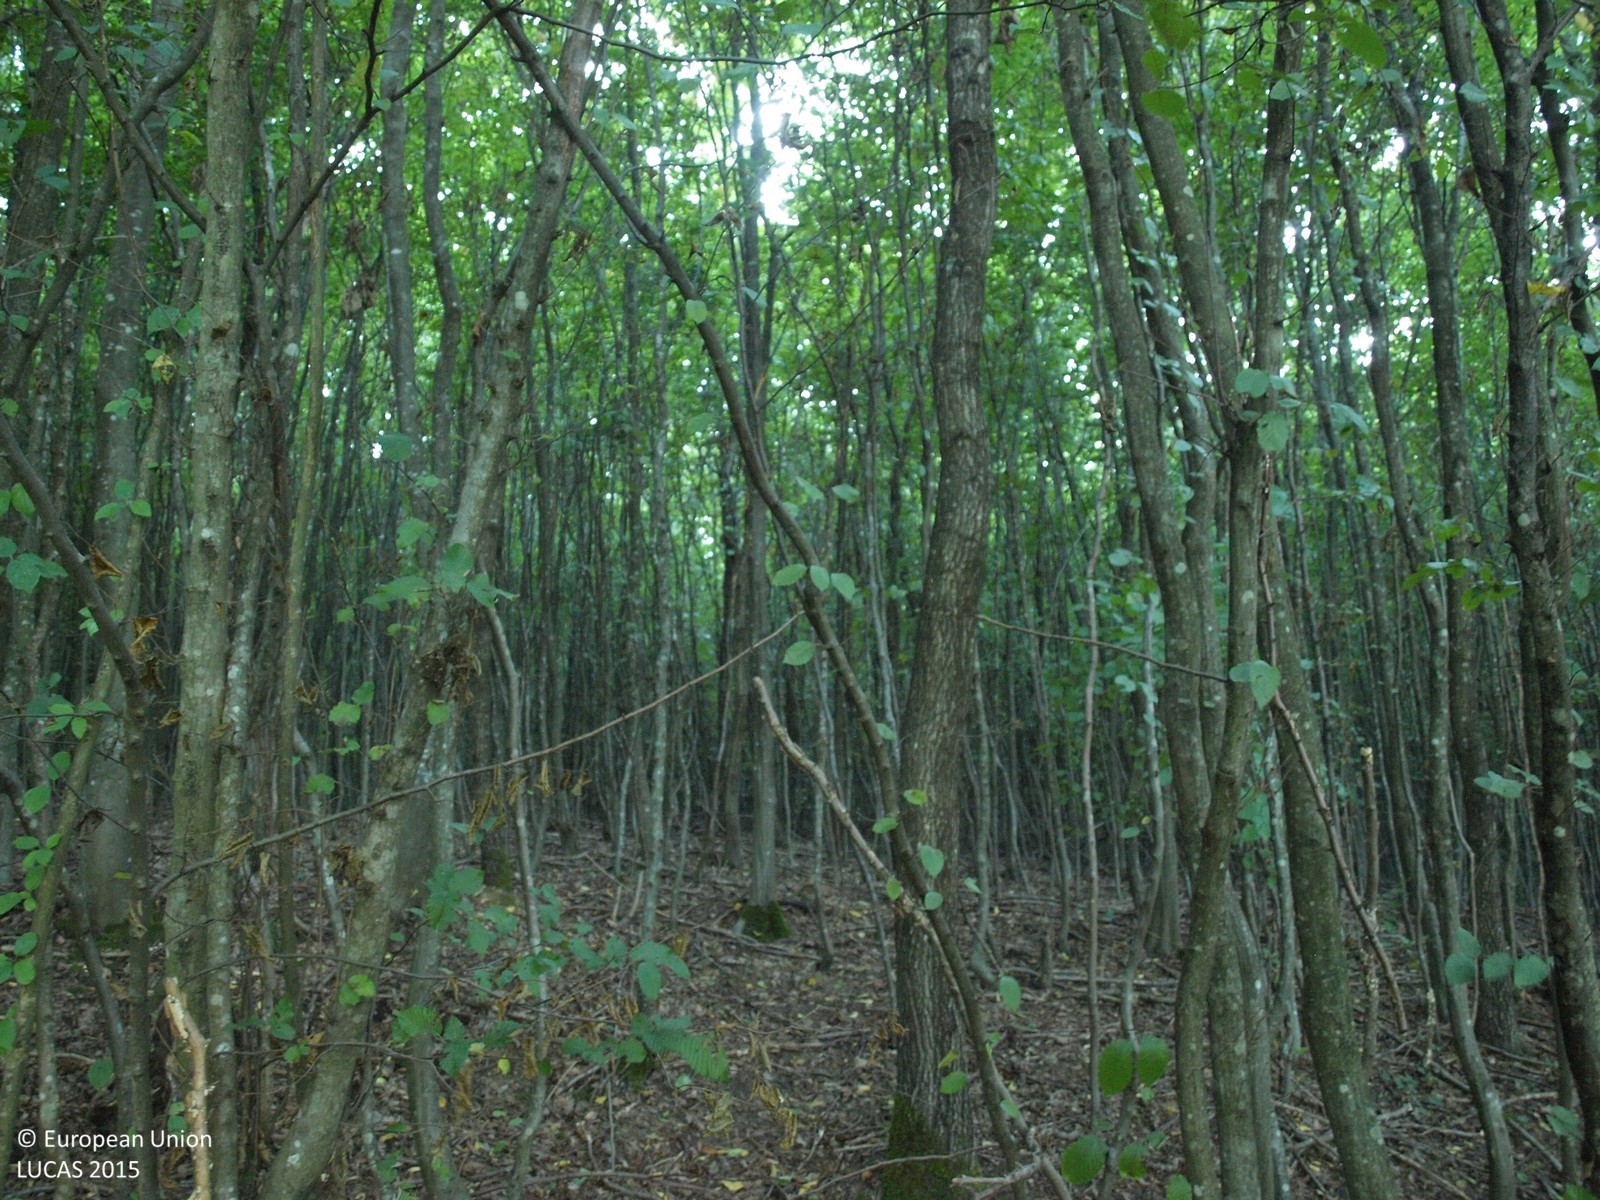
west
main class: Woodland
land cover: Broadleaved woodland
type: beech forest
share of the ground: > 75 %
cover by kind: broadleaved forest trees 100 %
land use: Forestry
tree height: > 5 m
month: August
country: HR
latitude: 46.0941
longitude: 16.5838
